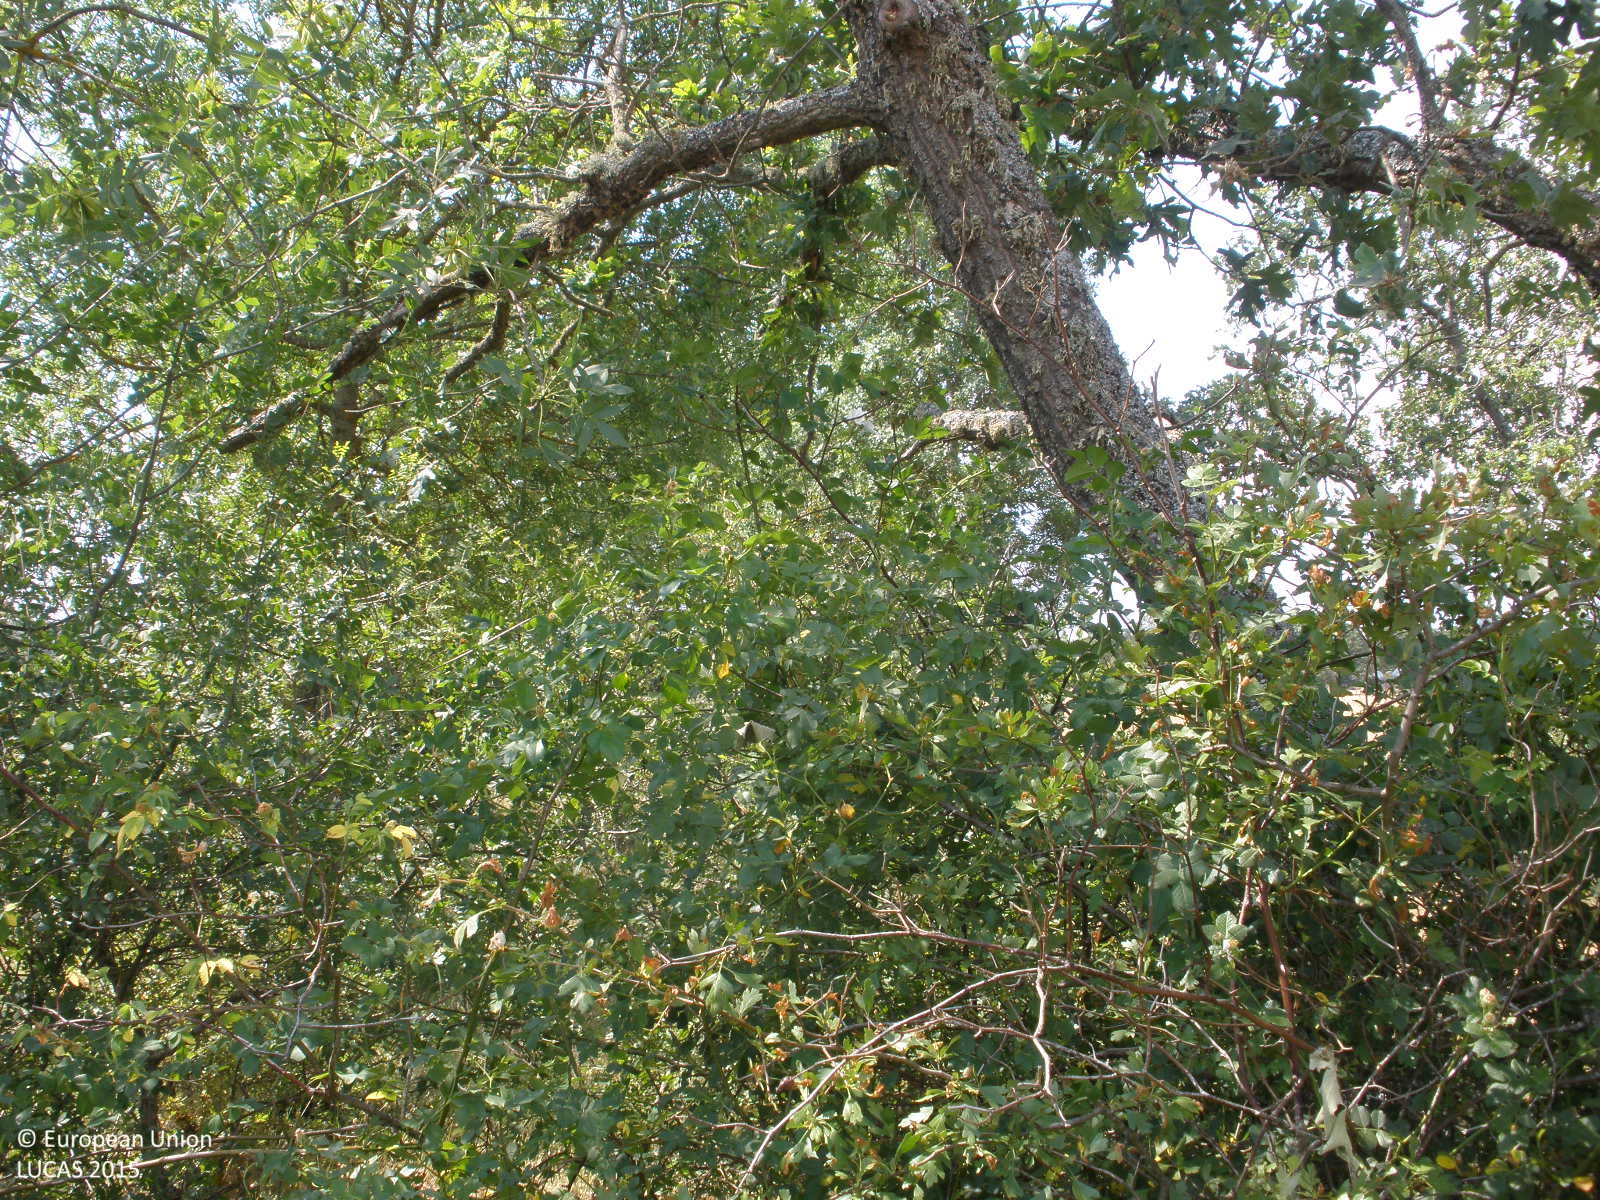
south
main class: Woodland
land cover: Broadleaved woodland
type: thermophilous deciduous forest
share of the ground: > 75 %
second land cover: Grassland without tree/shrub cover
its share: > 75 %
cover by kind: broadleaved forest trees 60 %, herbaceous plants 30 %, shrubs 10 %
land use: Forestry
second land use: Agriculture (excluding fallow land and kitchen gardens)
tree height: > 5 m
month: June
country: ES
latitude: 40.6099
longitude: -6.3853
